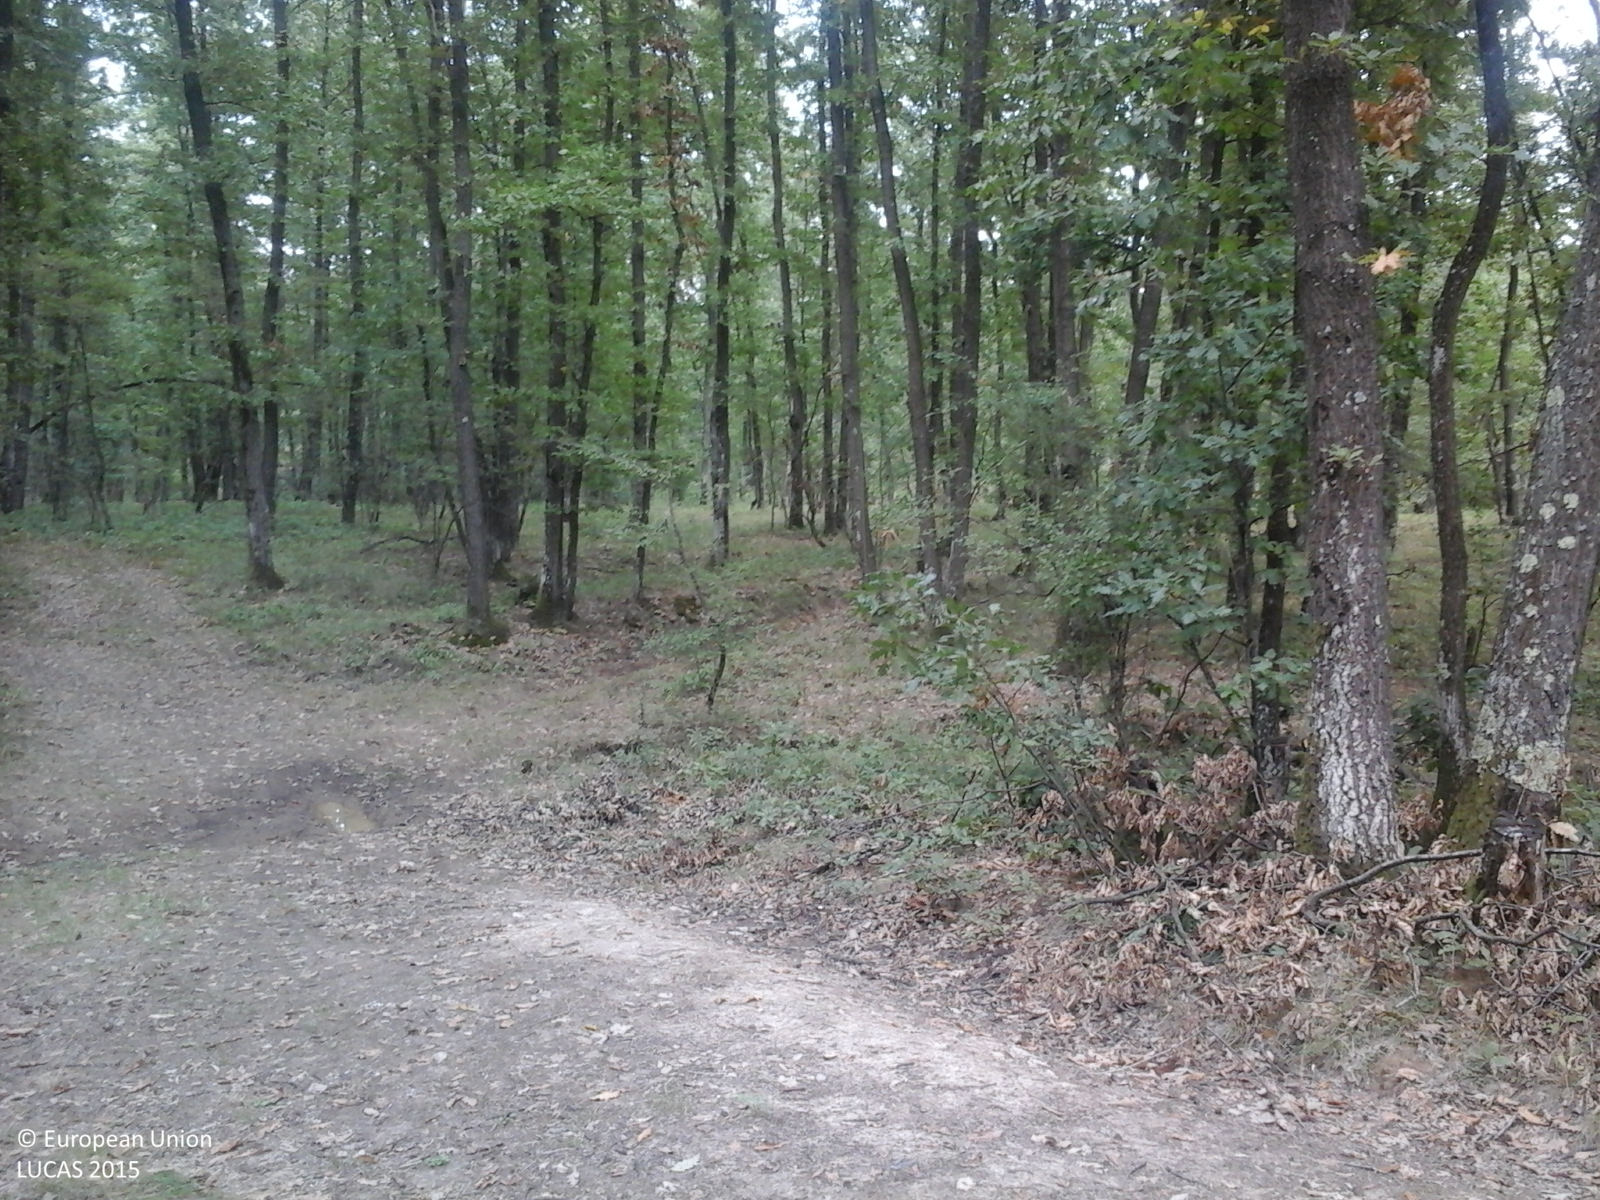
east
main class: Woodland
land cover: Broadleaved woodland
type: acidophilous oak and oak-birch forest
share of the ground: > 75 %
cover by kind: broadleaved forest trees 100 %
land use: Forestry
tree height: > 5 m
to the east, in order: Broadleaved woodland; Ditches and canals; Broadleaved woodland
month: September
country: RO
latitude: 45.0115
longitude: 23.1074
